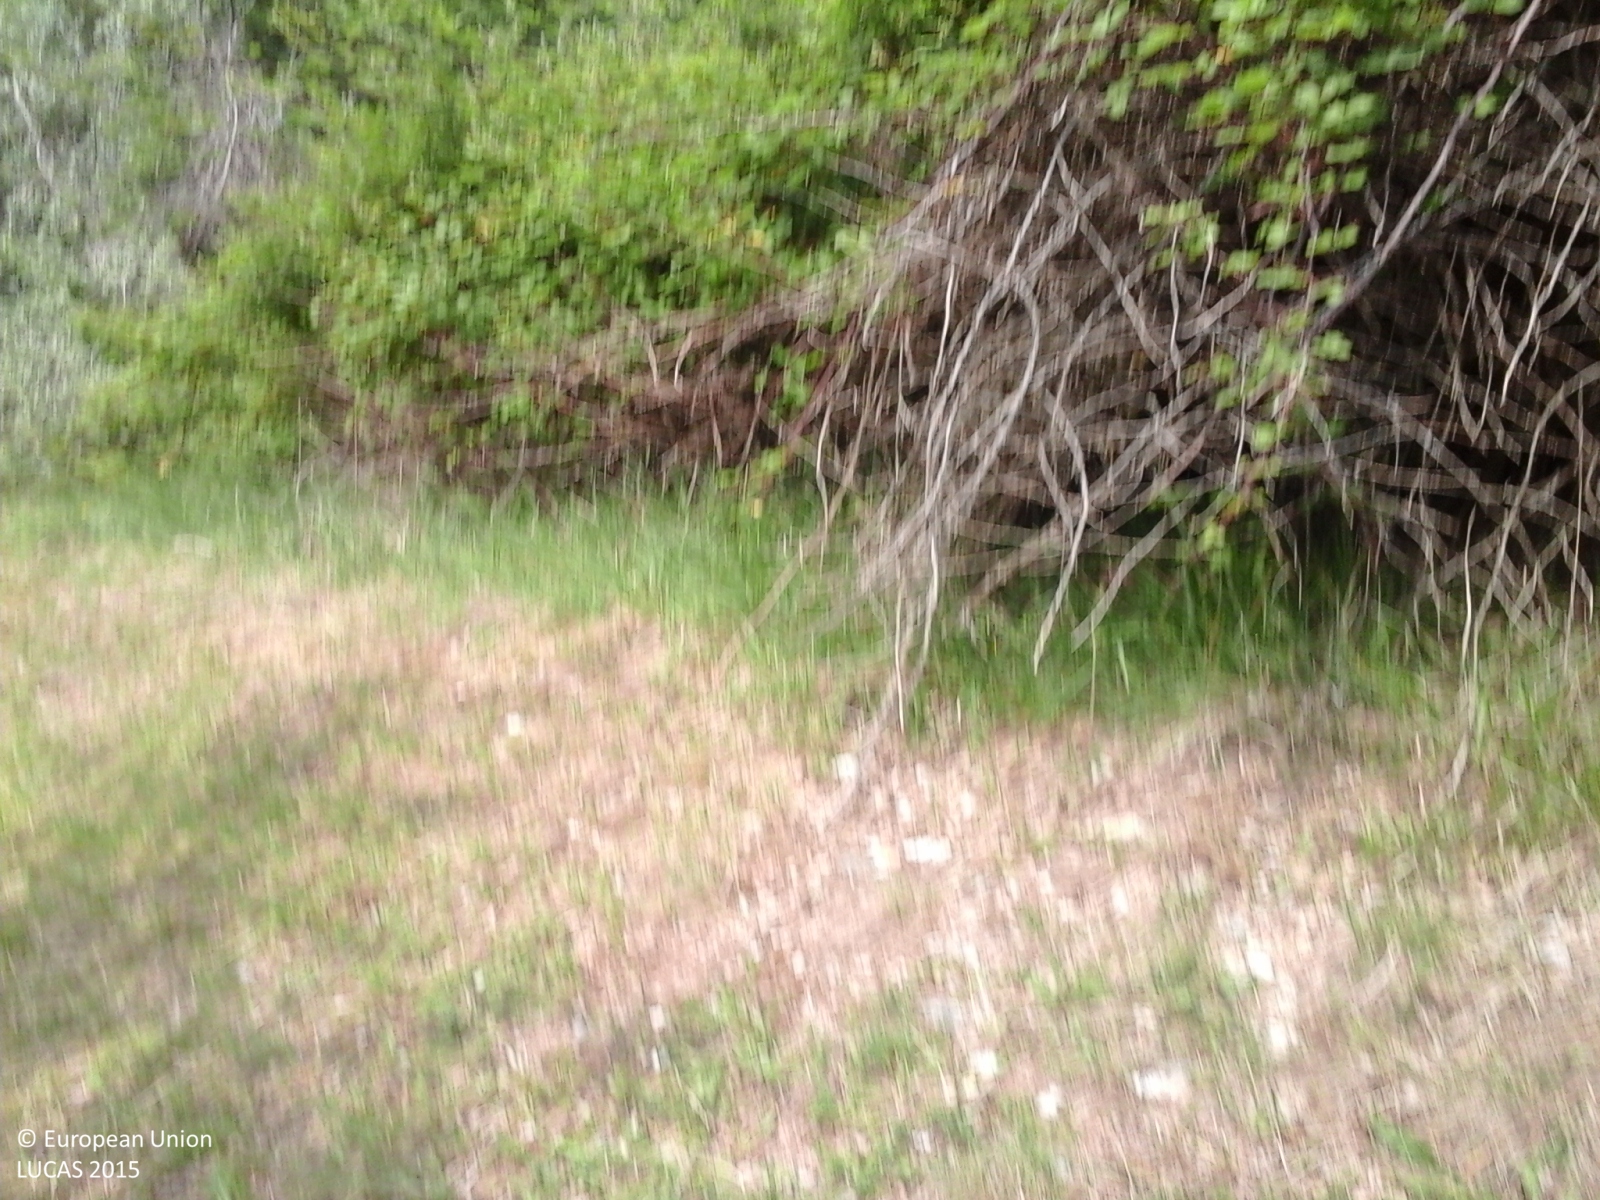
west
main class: Cropland
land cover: Olive groves
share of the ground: > 75 %
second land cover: Grassland without tree/shrub cover
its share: 50 - 75 %
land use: Agriculture (excluding fallow land and kitchen gardens)
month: June
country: IT
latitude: 41.7003
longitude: 13.6997
